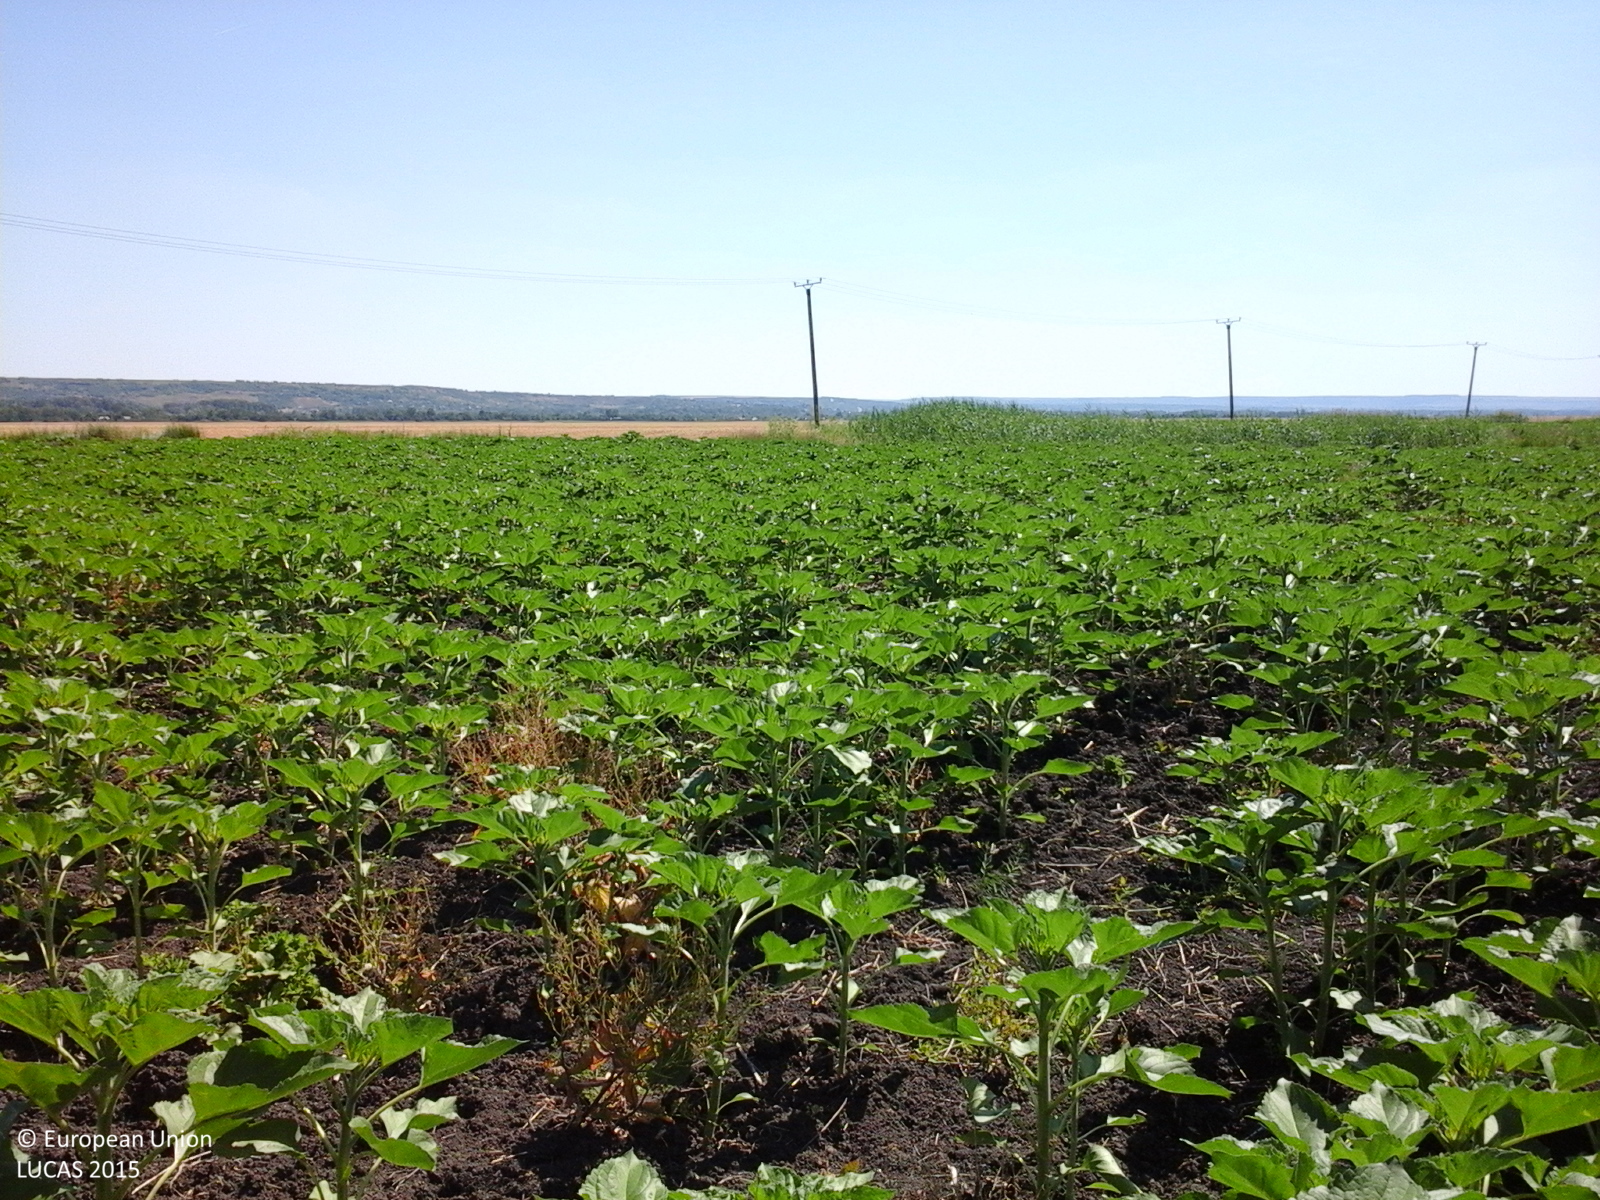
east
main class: Cropland
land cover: Sunflower
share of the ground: > 75 %
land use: Agriculture (excluding fallow land and kitchen gardens)
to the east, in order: Sunflower; Grass margins; Ditches and canals; Tracks; Ditches and canals; Grass margins; Common wheat; Electric lines; Common wheat
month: June
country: RO
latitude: 47.0316
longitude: 27.9325
